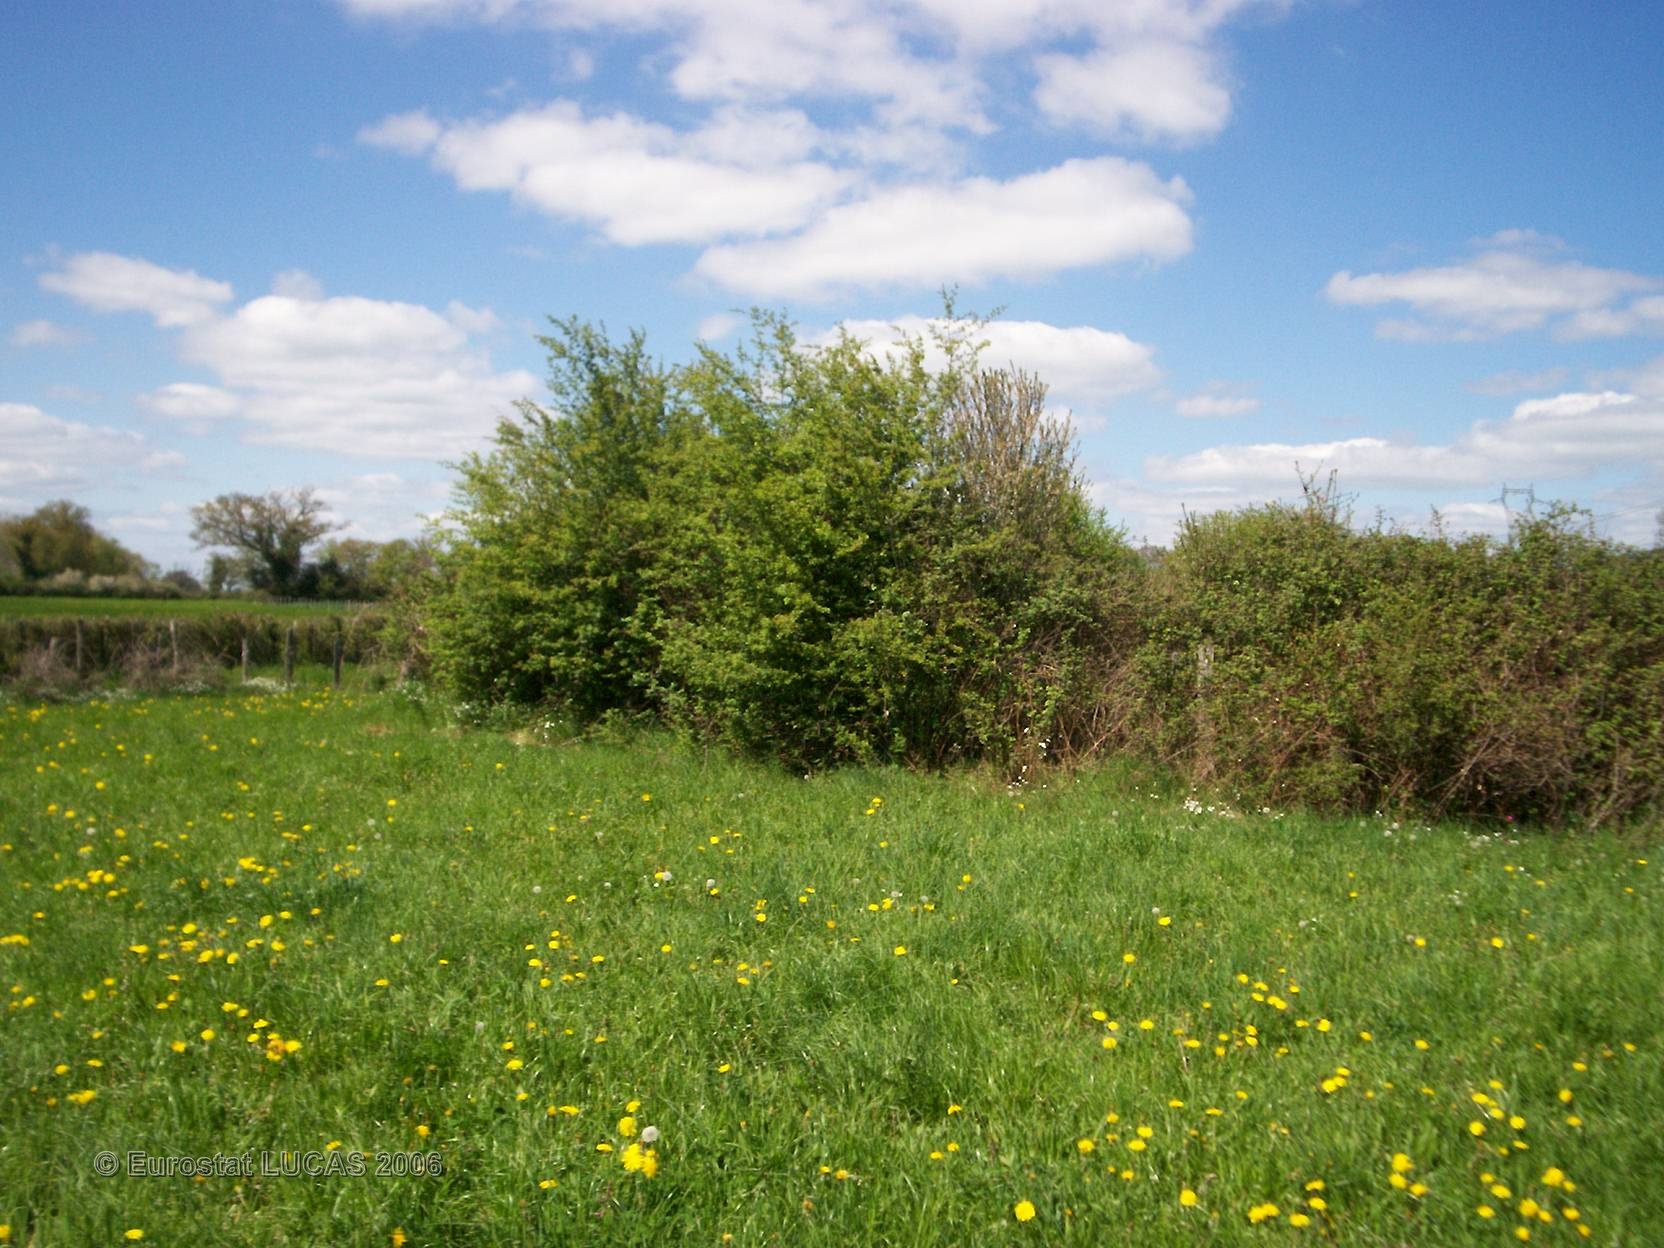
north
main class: Grassland
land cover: Grassland without tree/shrub cover
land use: Agriculture (excluding fallow land and kitchen gardens)
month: April
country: FR
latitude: 46.2239
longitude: 1.6553
